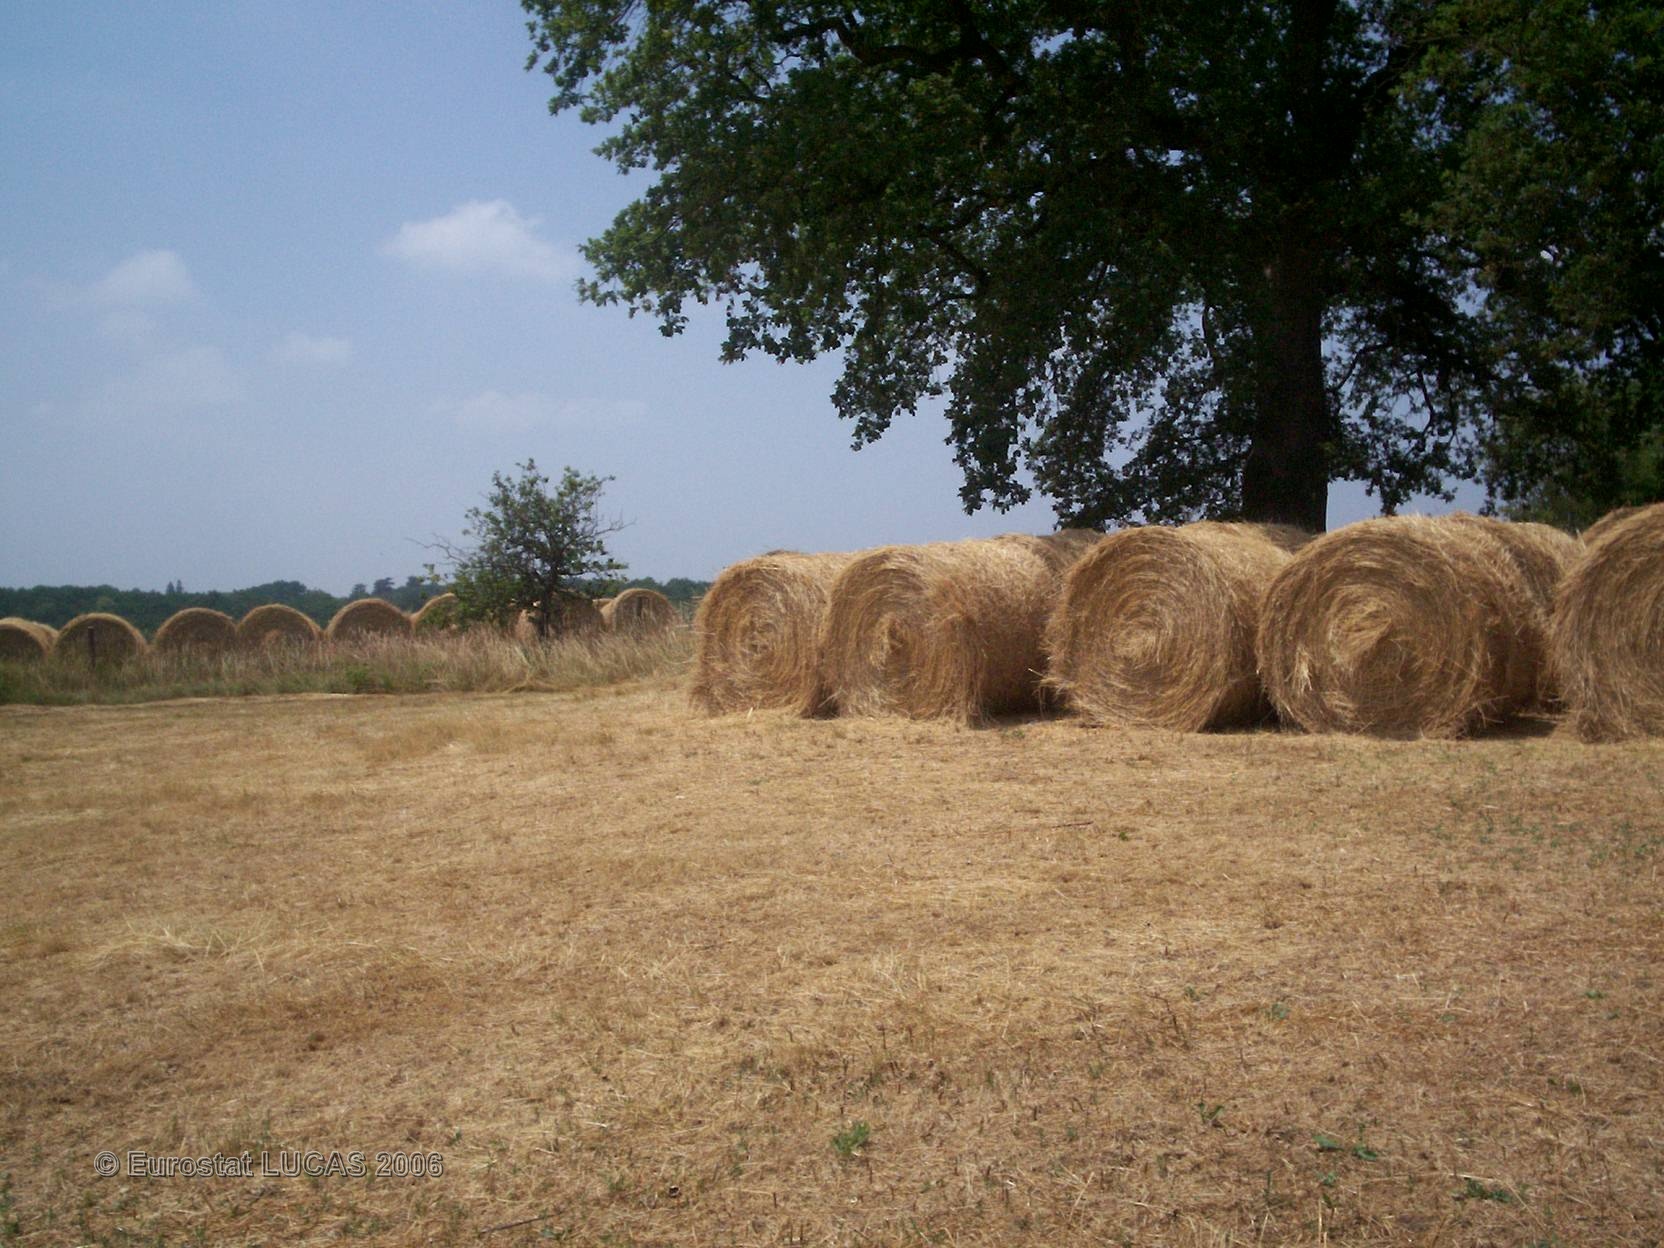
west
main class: Grassland
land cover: Grassland without tree/shrub cover
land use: Agriculture (excluding fallow land and kitchen gardens)
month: June
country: FR
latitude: 43.2760
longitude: 0.8710
